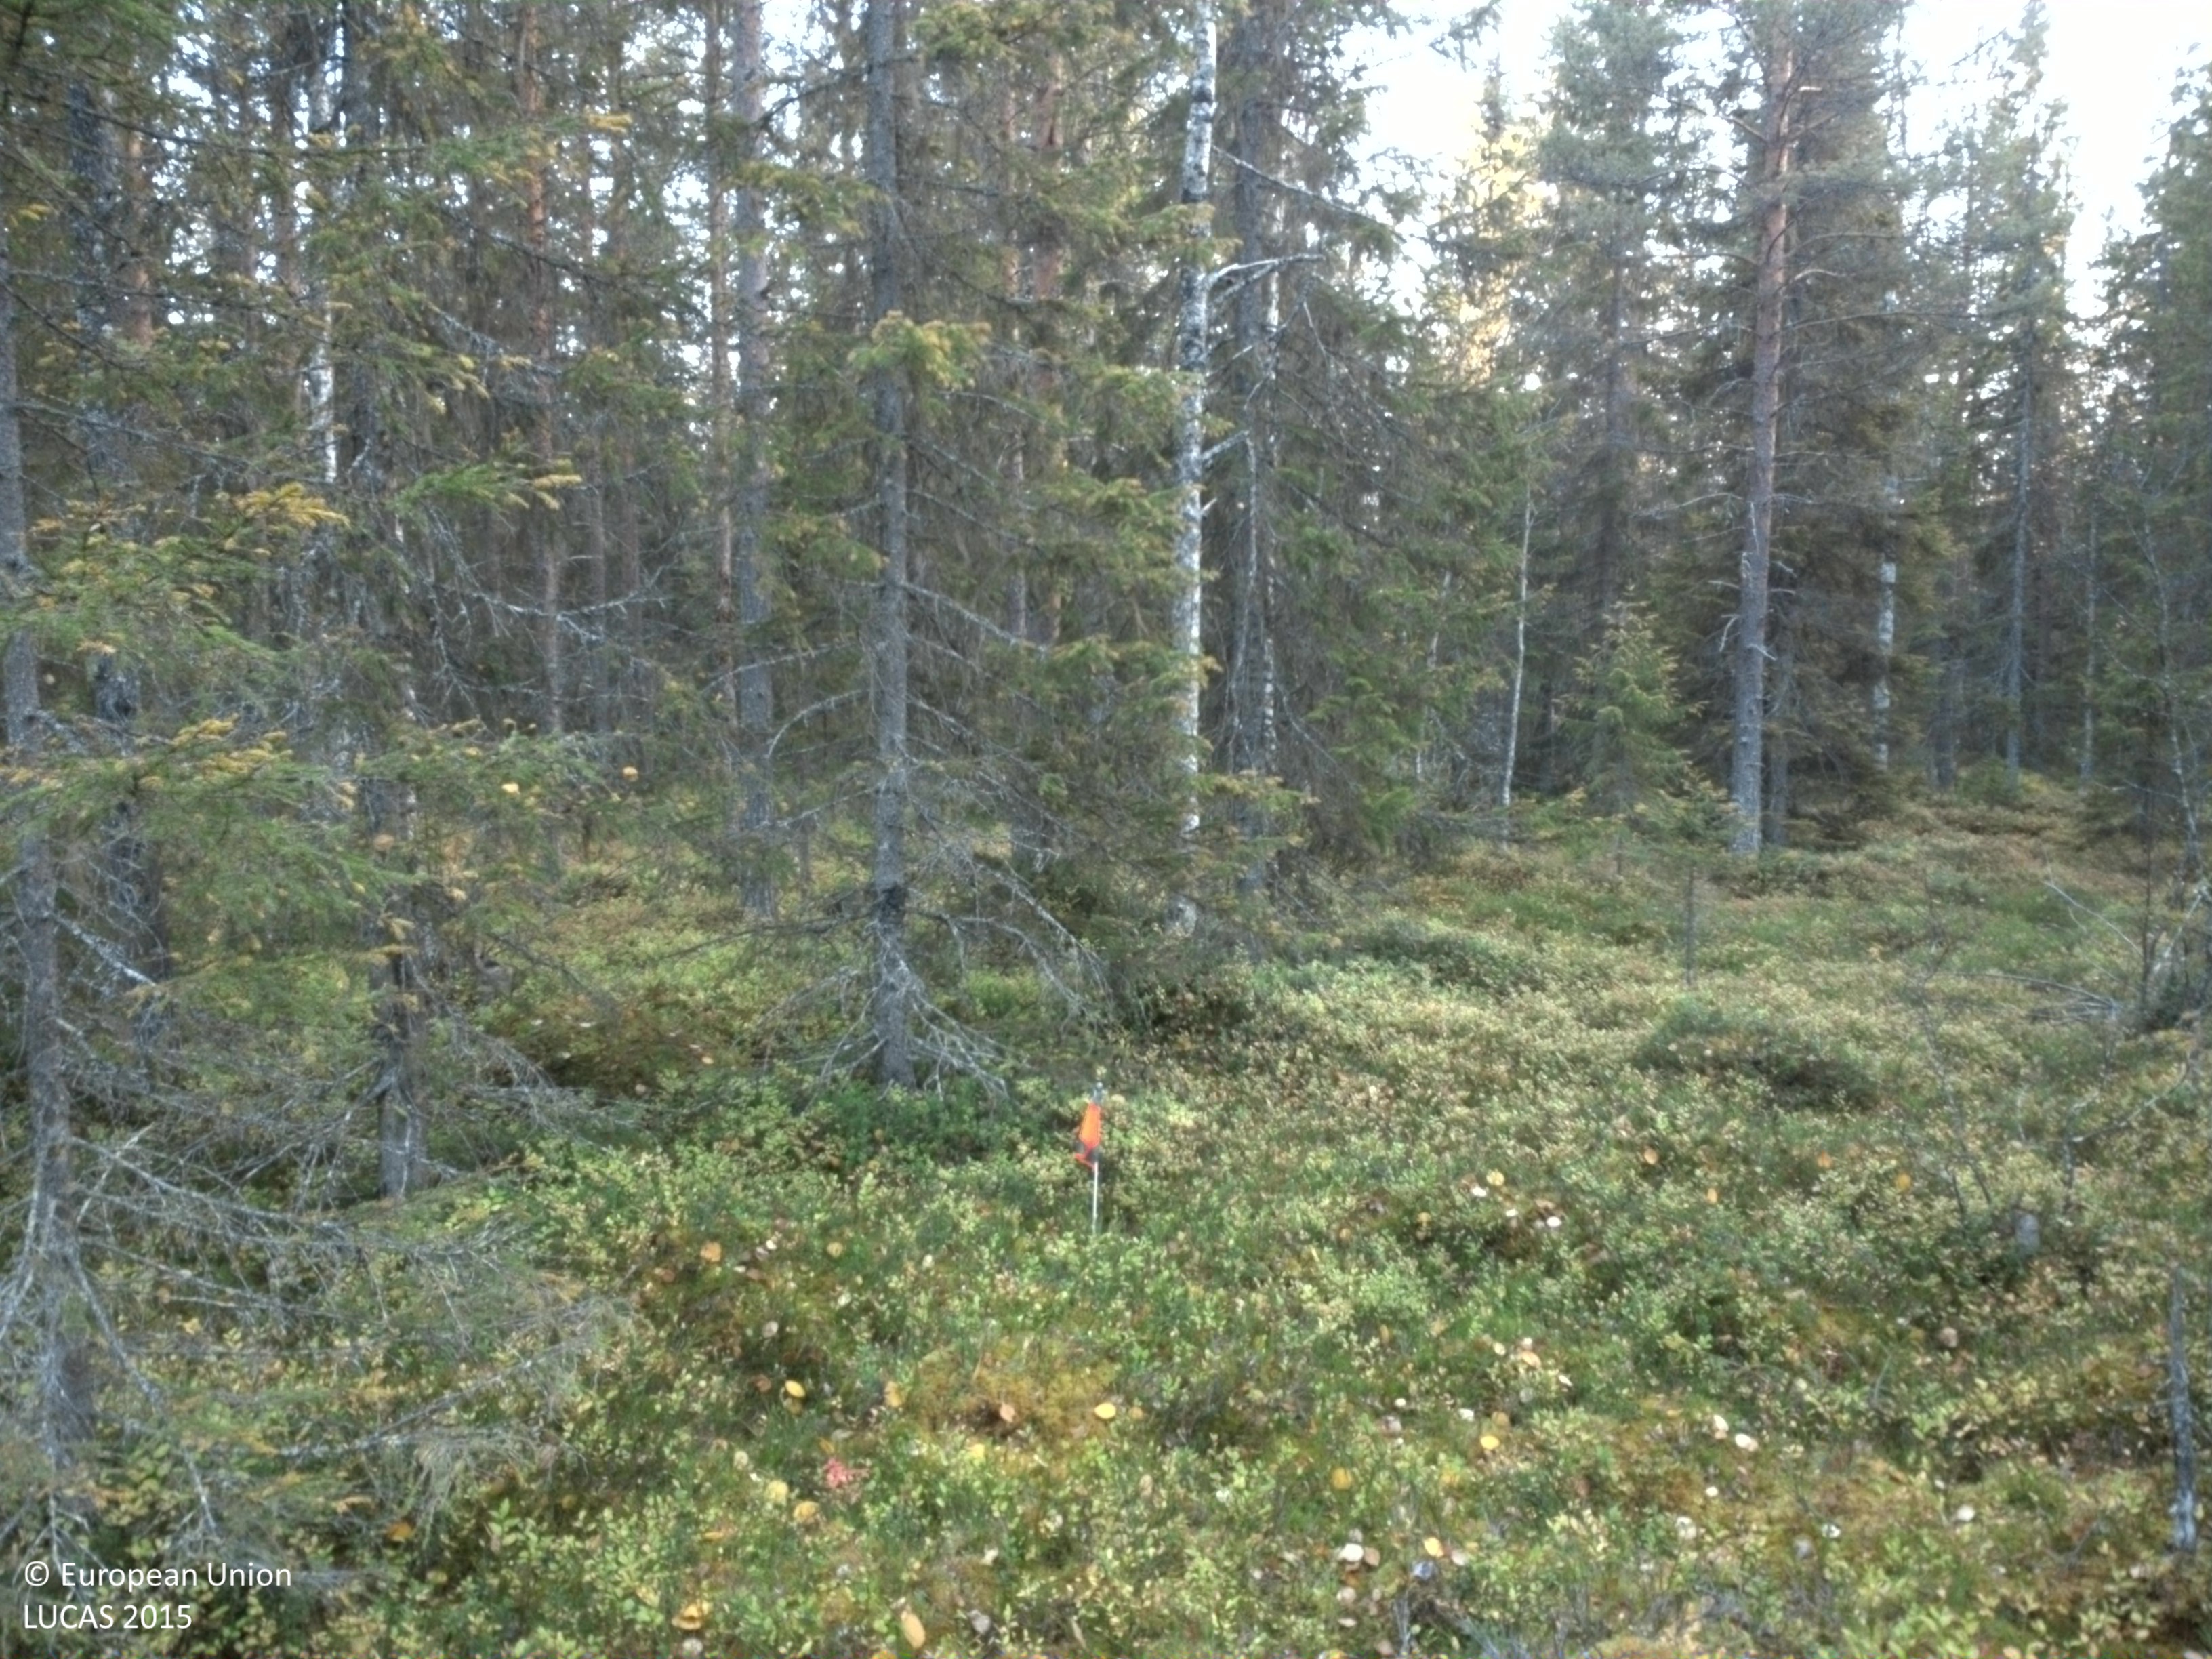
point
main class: Woodland
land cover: Other mixed woodland
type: boreal forest
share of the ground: 25 - 50 %
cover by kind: shrubs 40 %, broadleaved forest trees 25 %, lichens and mosses 20 %, coniferous forest trees 10 %, herbaceous plants 5 %
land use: Forestry
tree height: > 5 m
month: September
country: SE
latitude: 64.9999
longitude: 17.5343
